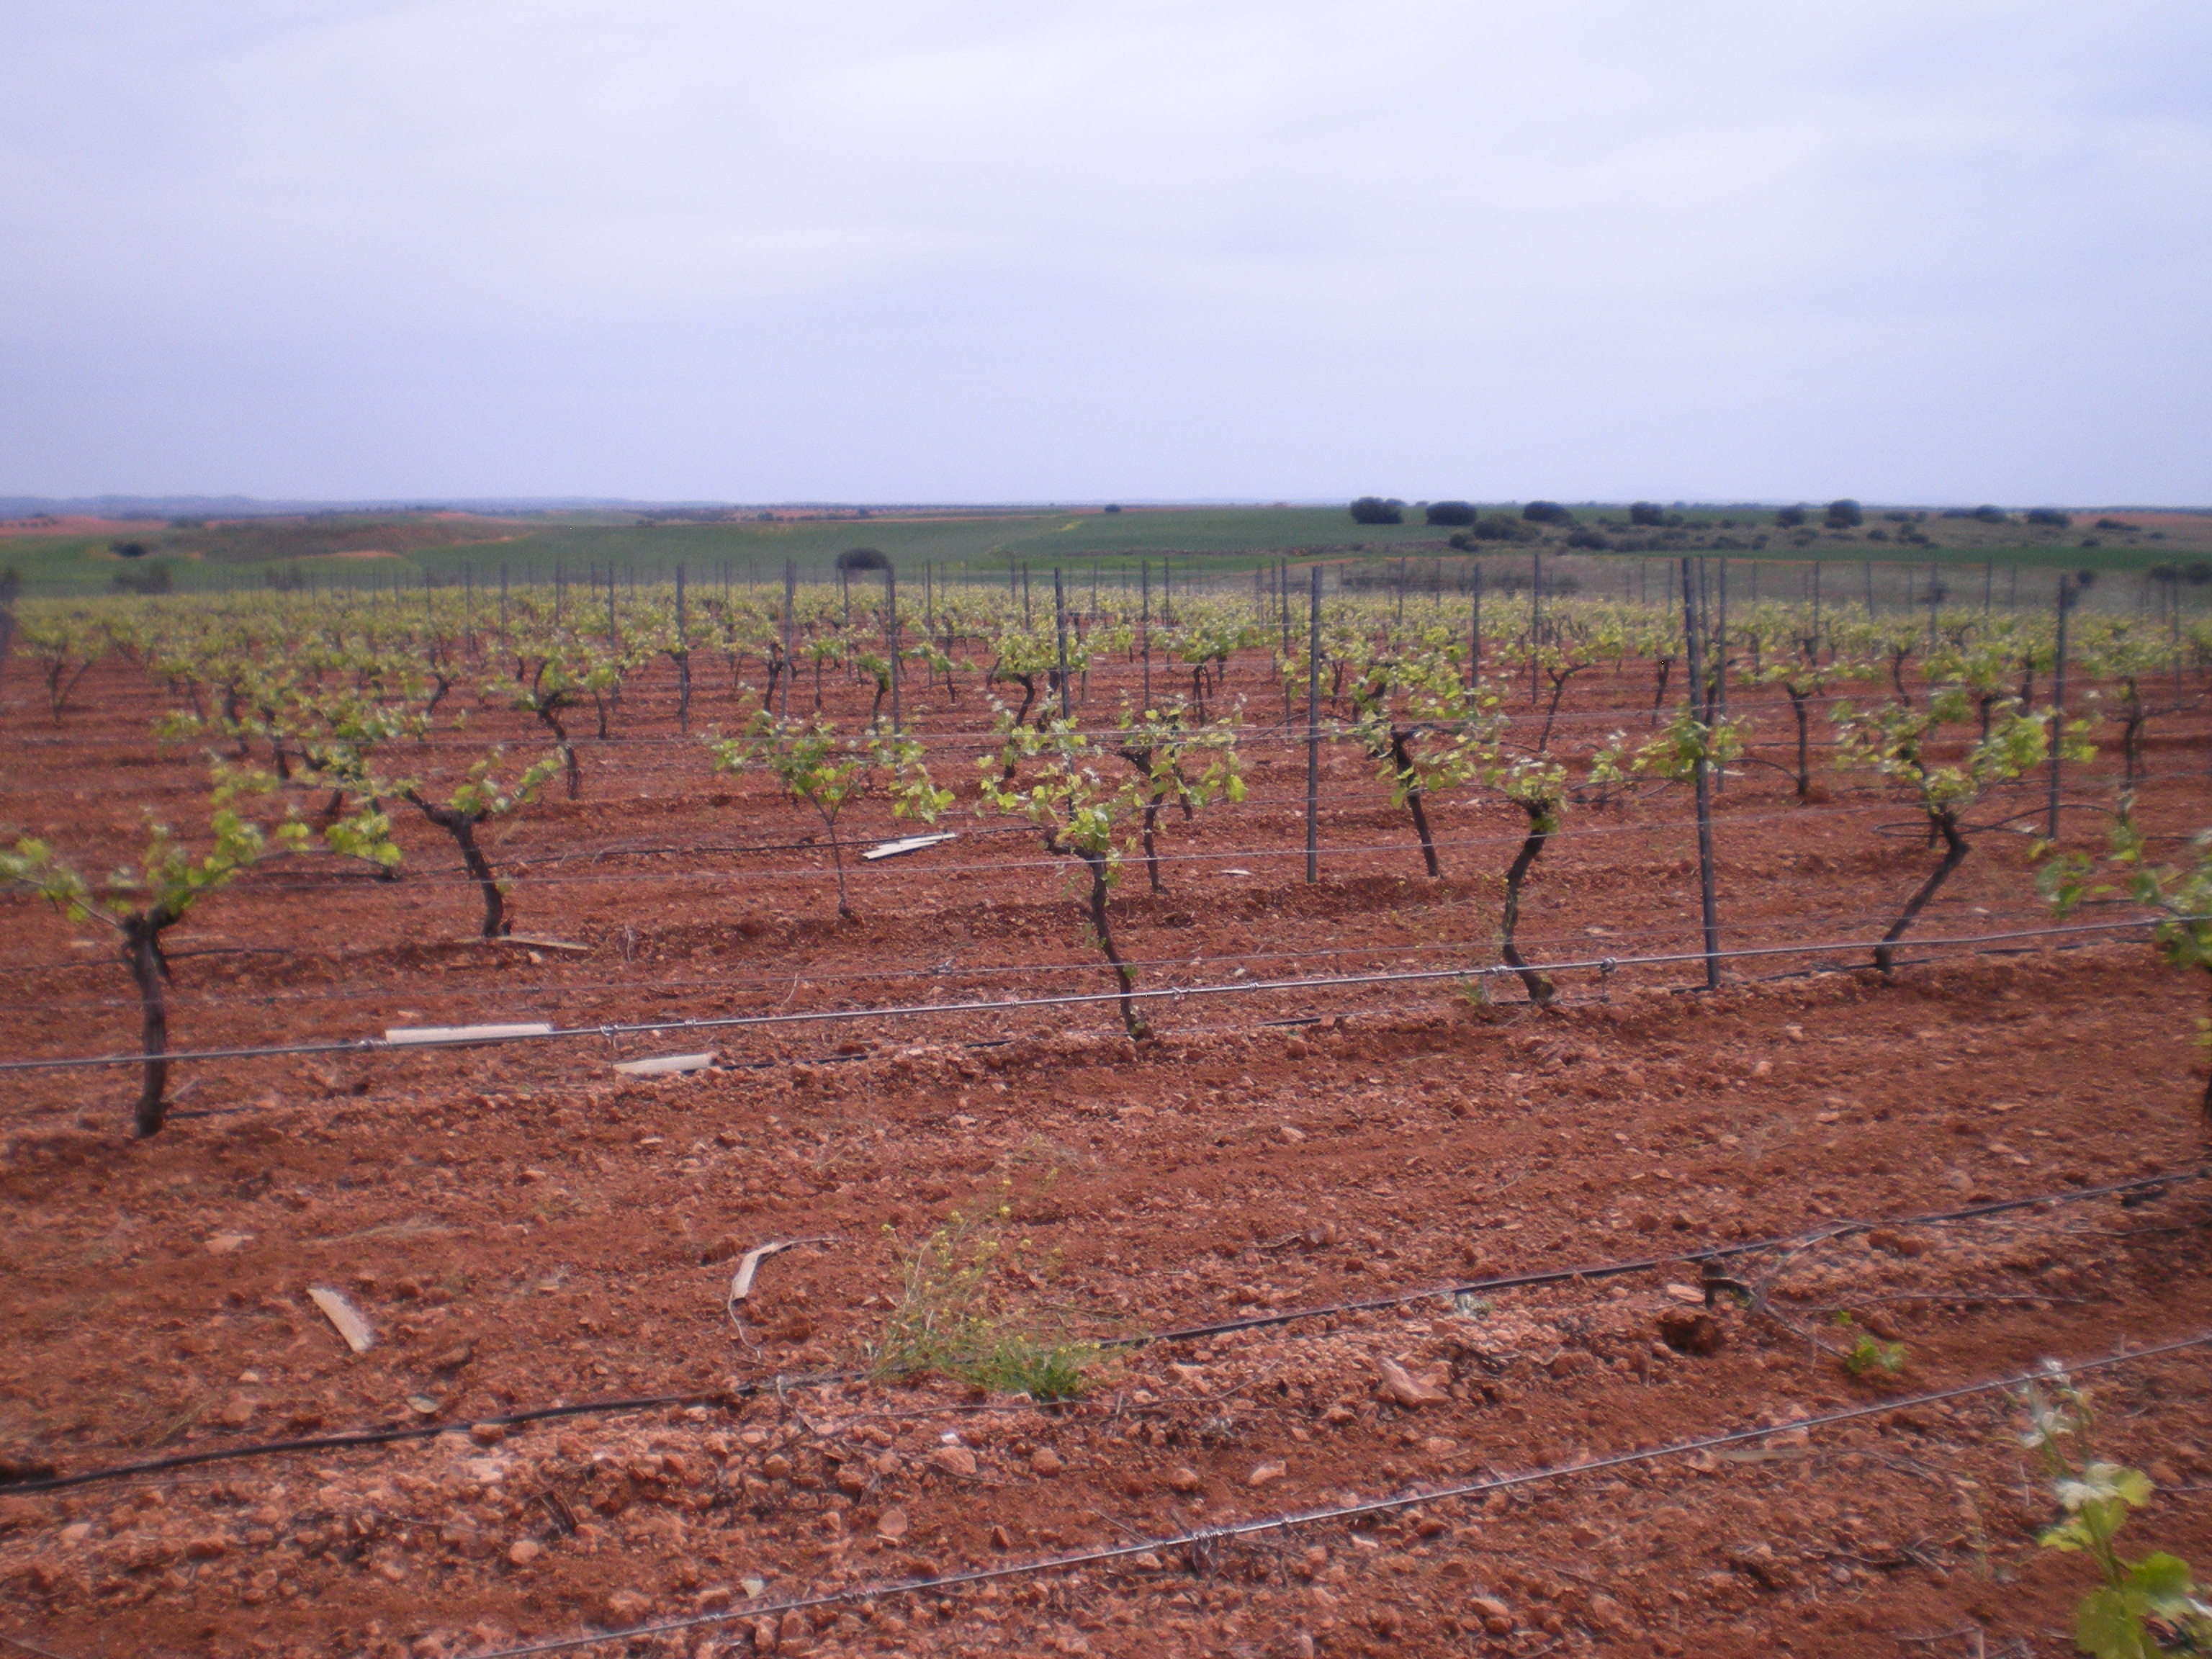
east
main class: Cropland
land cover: Vineyards
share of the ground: < 10 %
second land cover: Other bare soil
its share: > 75 %
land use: Agriculture (excluding fallow land and kitchen gardens)
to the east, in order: Vineyards; Other bare soil; Grass margins; Olive groves; Barley
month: May
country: ES
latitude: 38.7182
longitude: -3.1538
